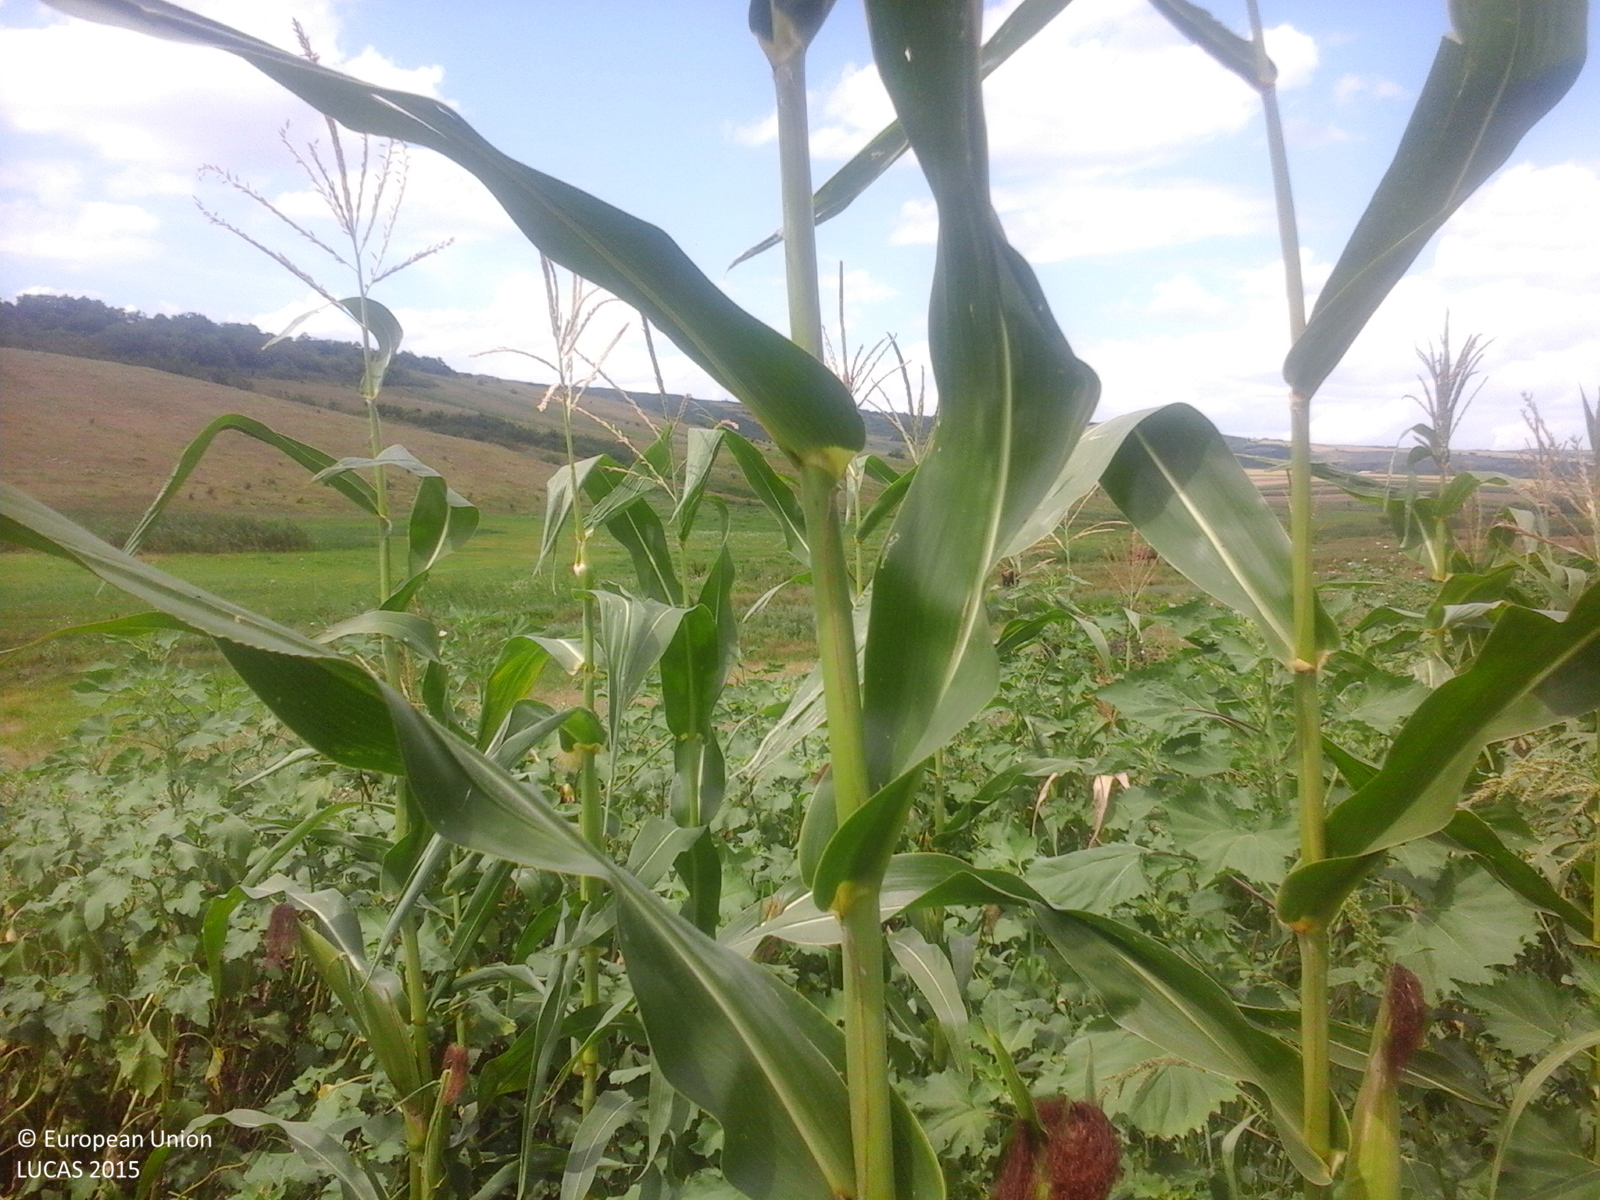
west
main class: Cropland
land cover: Maize
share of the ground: > 75 %
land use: Agriculture (excluding fallow land and kitchen gardens)
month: July
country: RO
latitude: 46.5227
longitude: 27.9985
